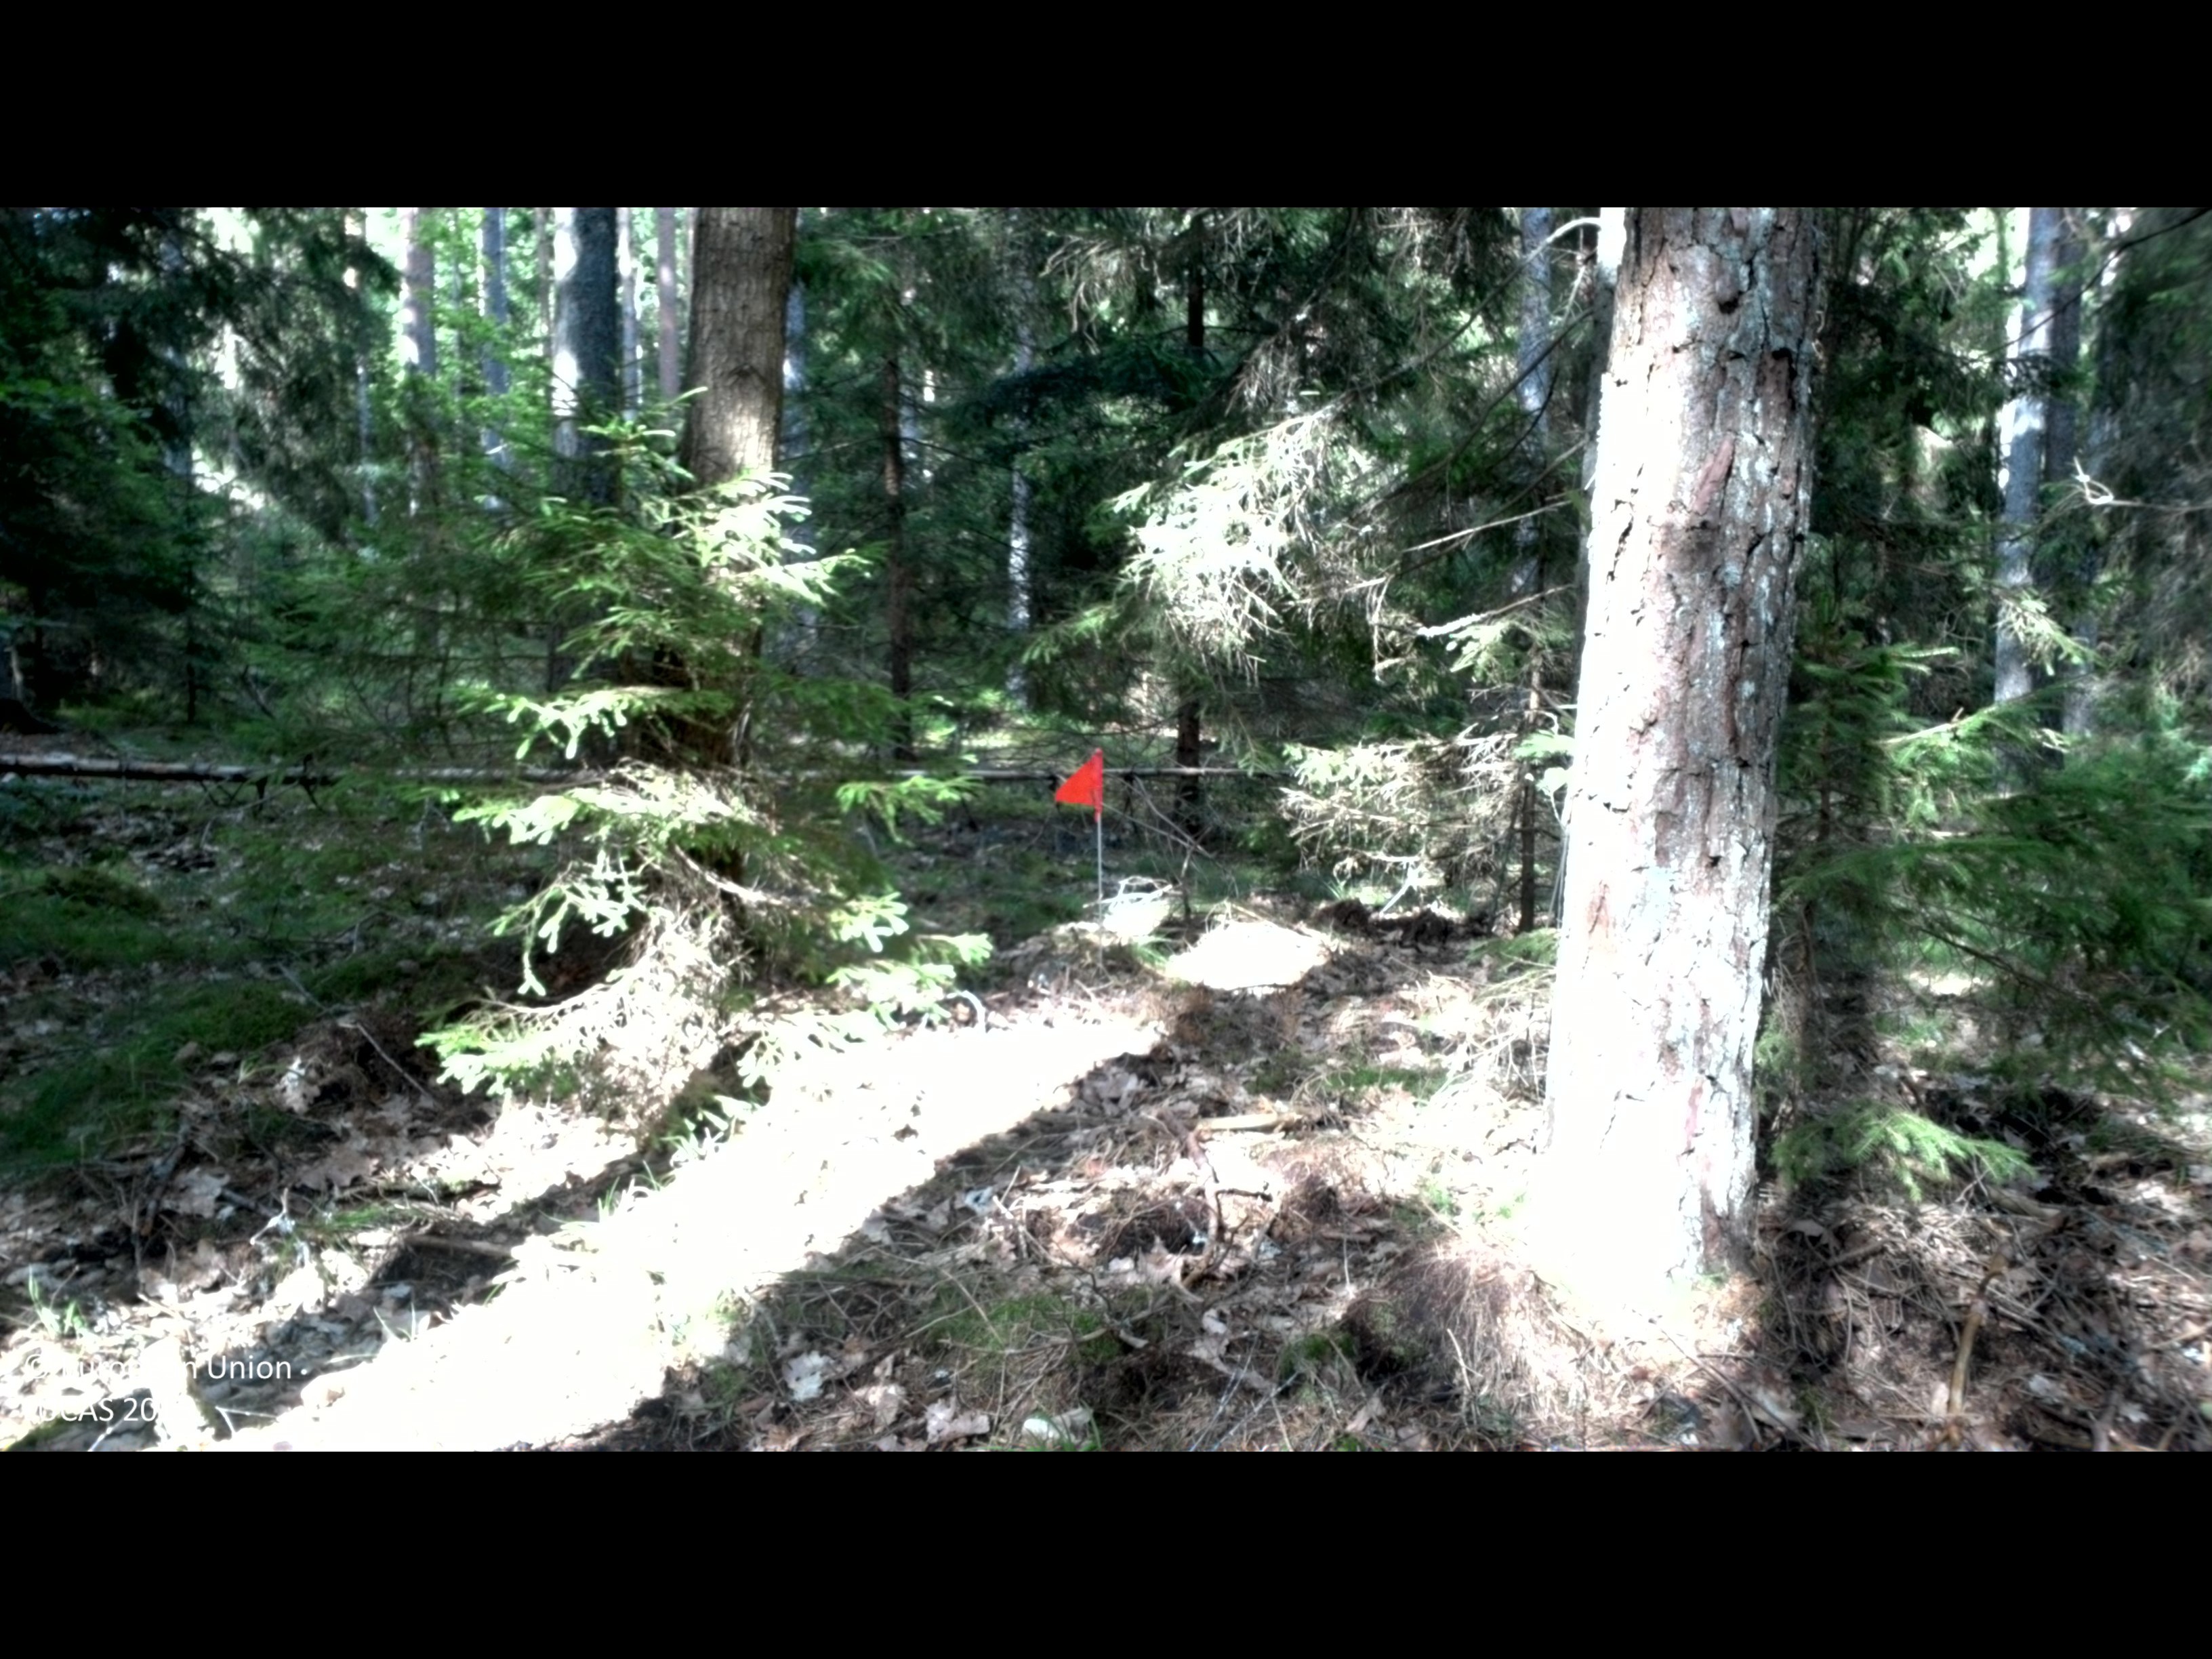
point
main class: Woodland
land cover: Spruce dominated coniferous woodland
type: boreal forest
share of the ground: > 75 %
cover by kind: coniferous forest trees 75 %, lichens and mosses 20 %, herbaceous plants 5 %
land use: Forestry
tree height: > 5 m
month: July
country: SE
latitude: 56.4397
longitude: 14.8152
